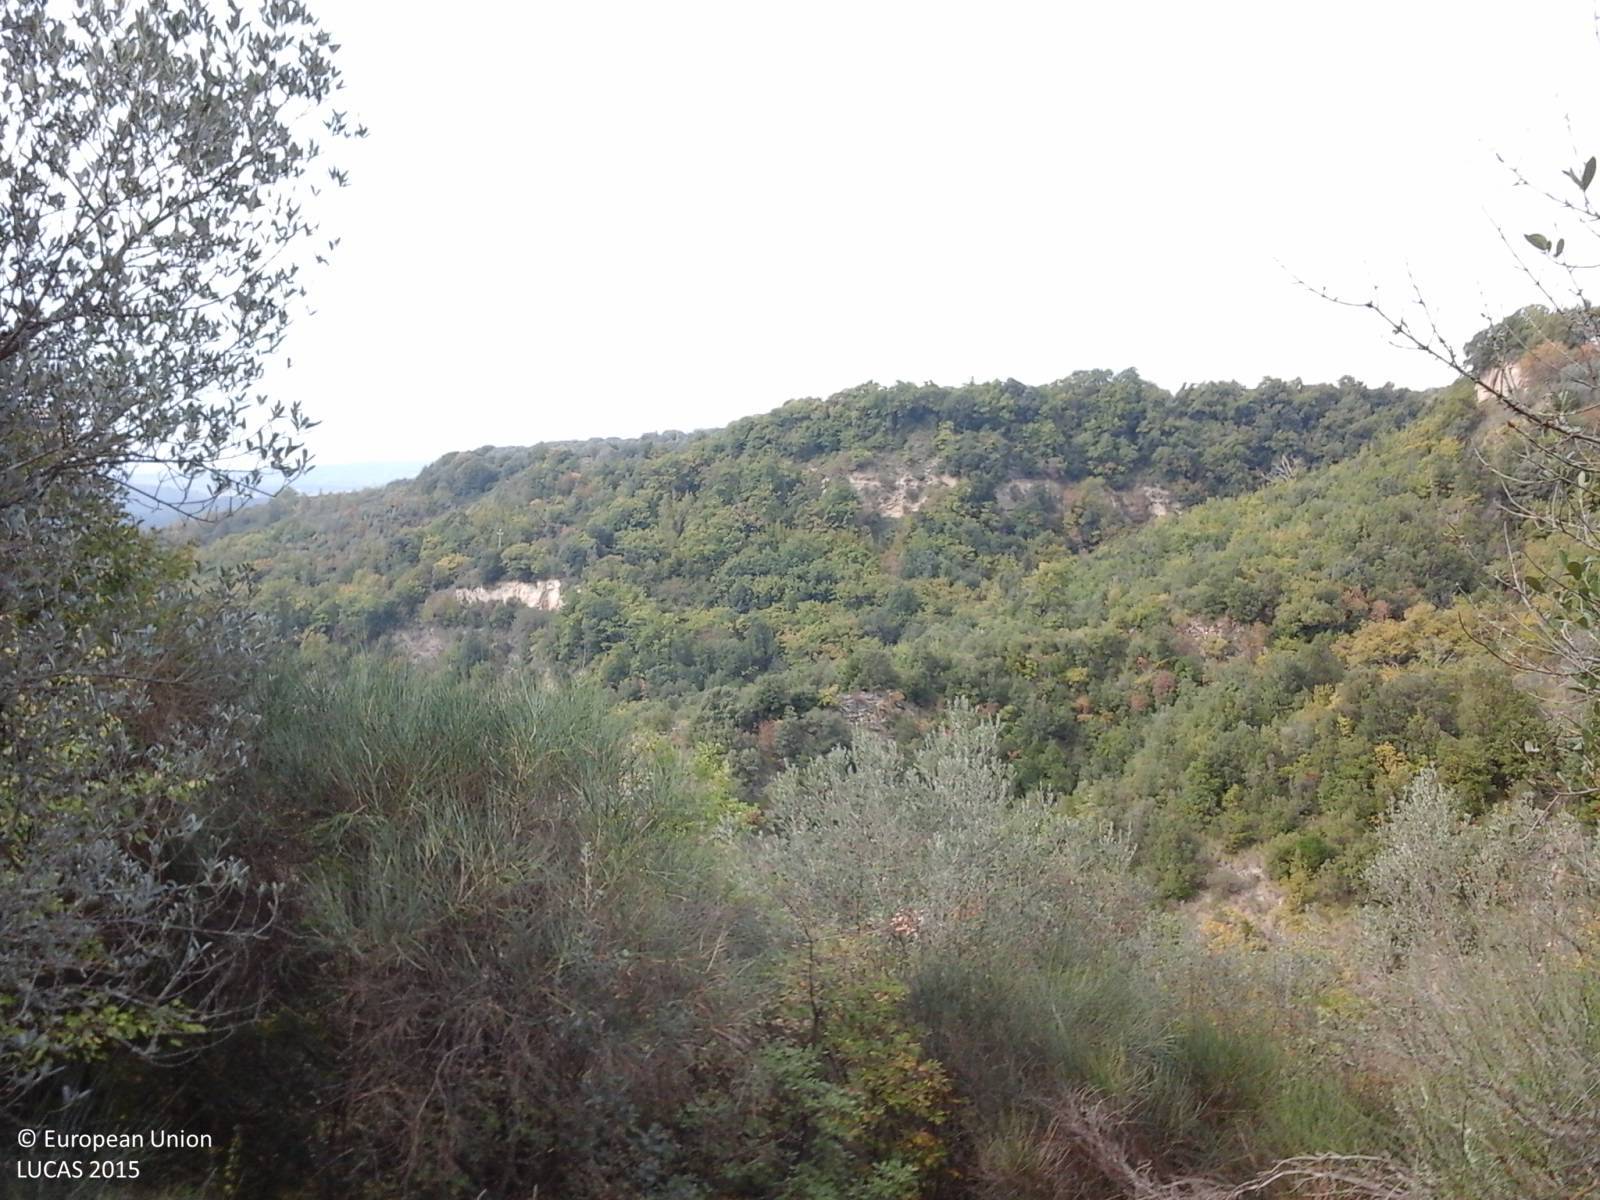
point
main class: Woodland
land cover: Broadleaved woodland
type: thermophilous deciduous forest
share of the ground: > 75 %
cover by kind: broadleaved forest trees 75 %, shrubs 20 %, herbaceous plants 5 %
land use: Semi-natural and natural areas not in use
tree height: > 5 m
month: October
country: IT
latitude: 42.7188
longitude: 12.2763
